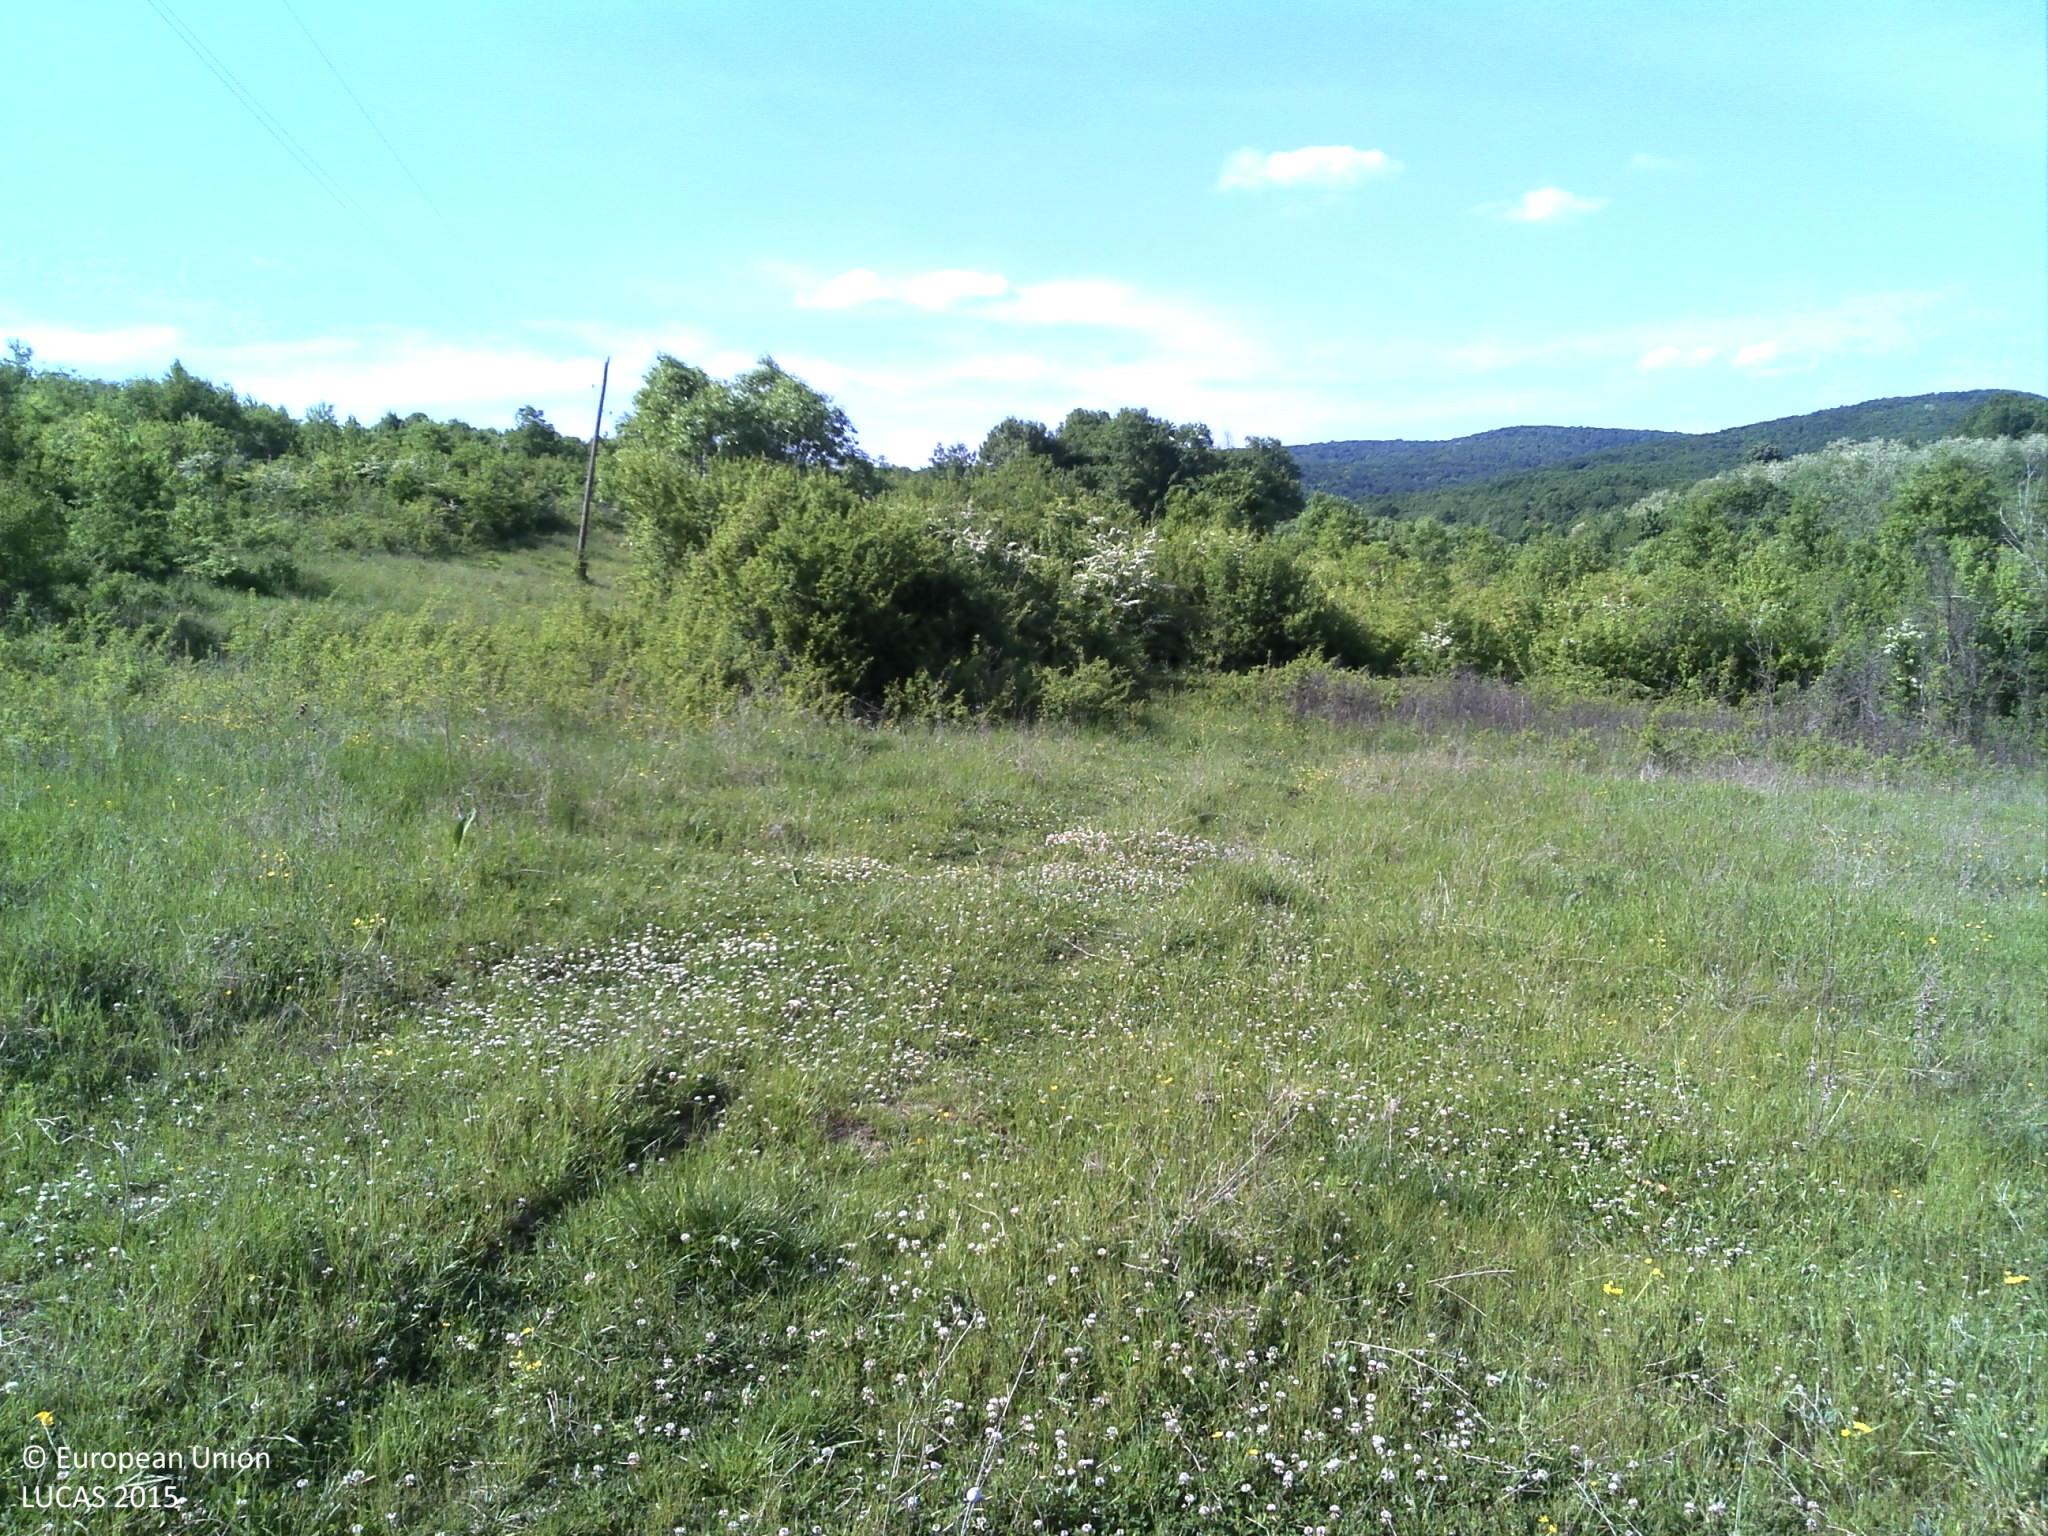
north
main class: Cropland
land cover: Clovers
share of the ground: > 75 %
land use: Agriculture (excluding fallow land and kitchen gardens)
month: May
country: HR
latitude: 45.2297
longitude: 18.0910
